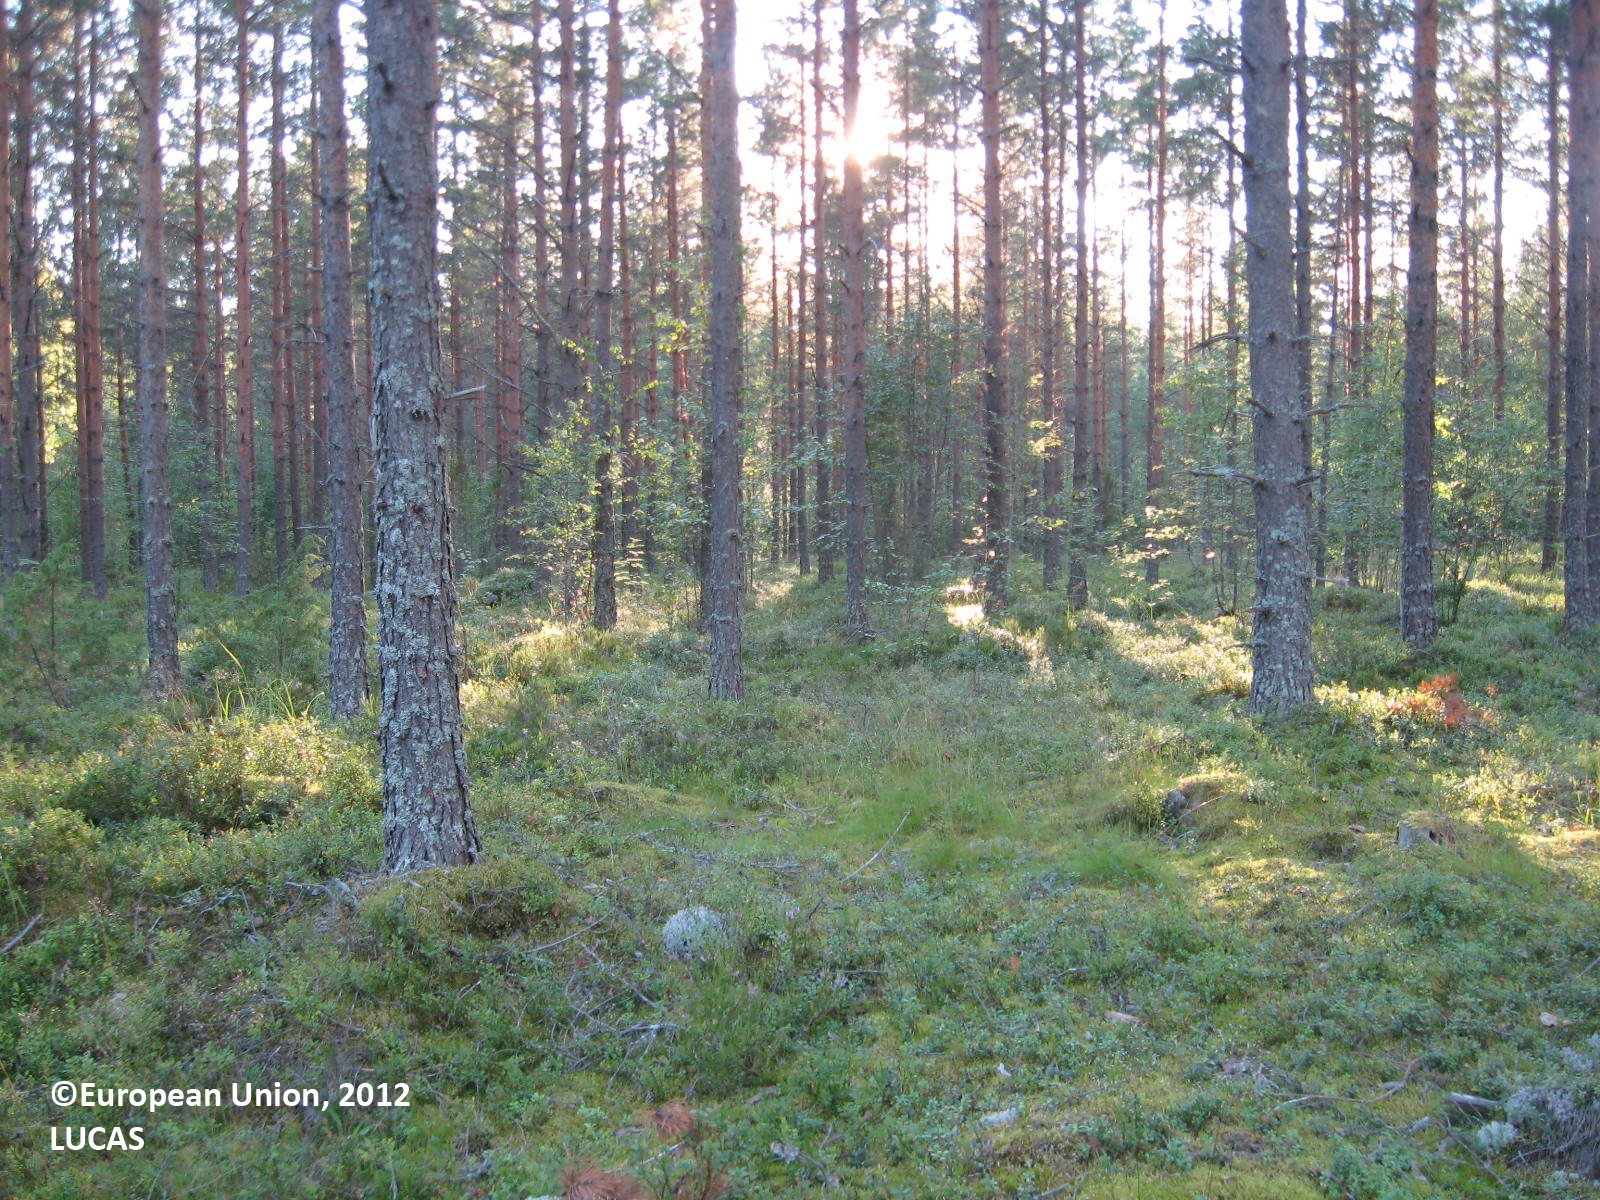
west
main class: Woodland
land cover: Pine dominated coniferous woodland
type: boreal forest
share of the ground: > 75 %
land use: Forestry
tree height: > 5 m
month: July
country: FI
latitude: 61.9435
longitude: 22.2735
